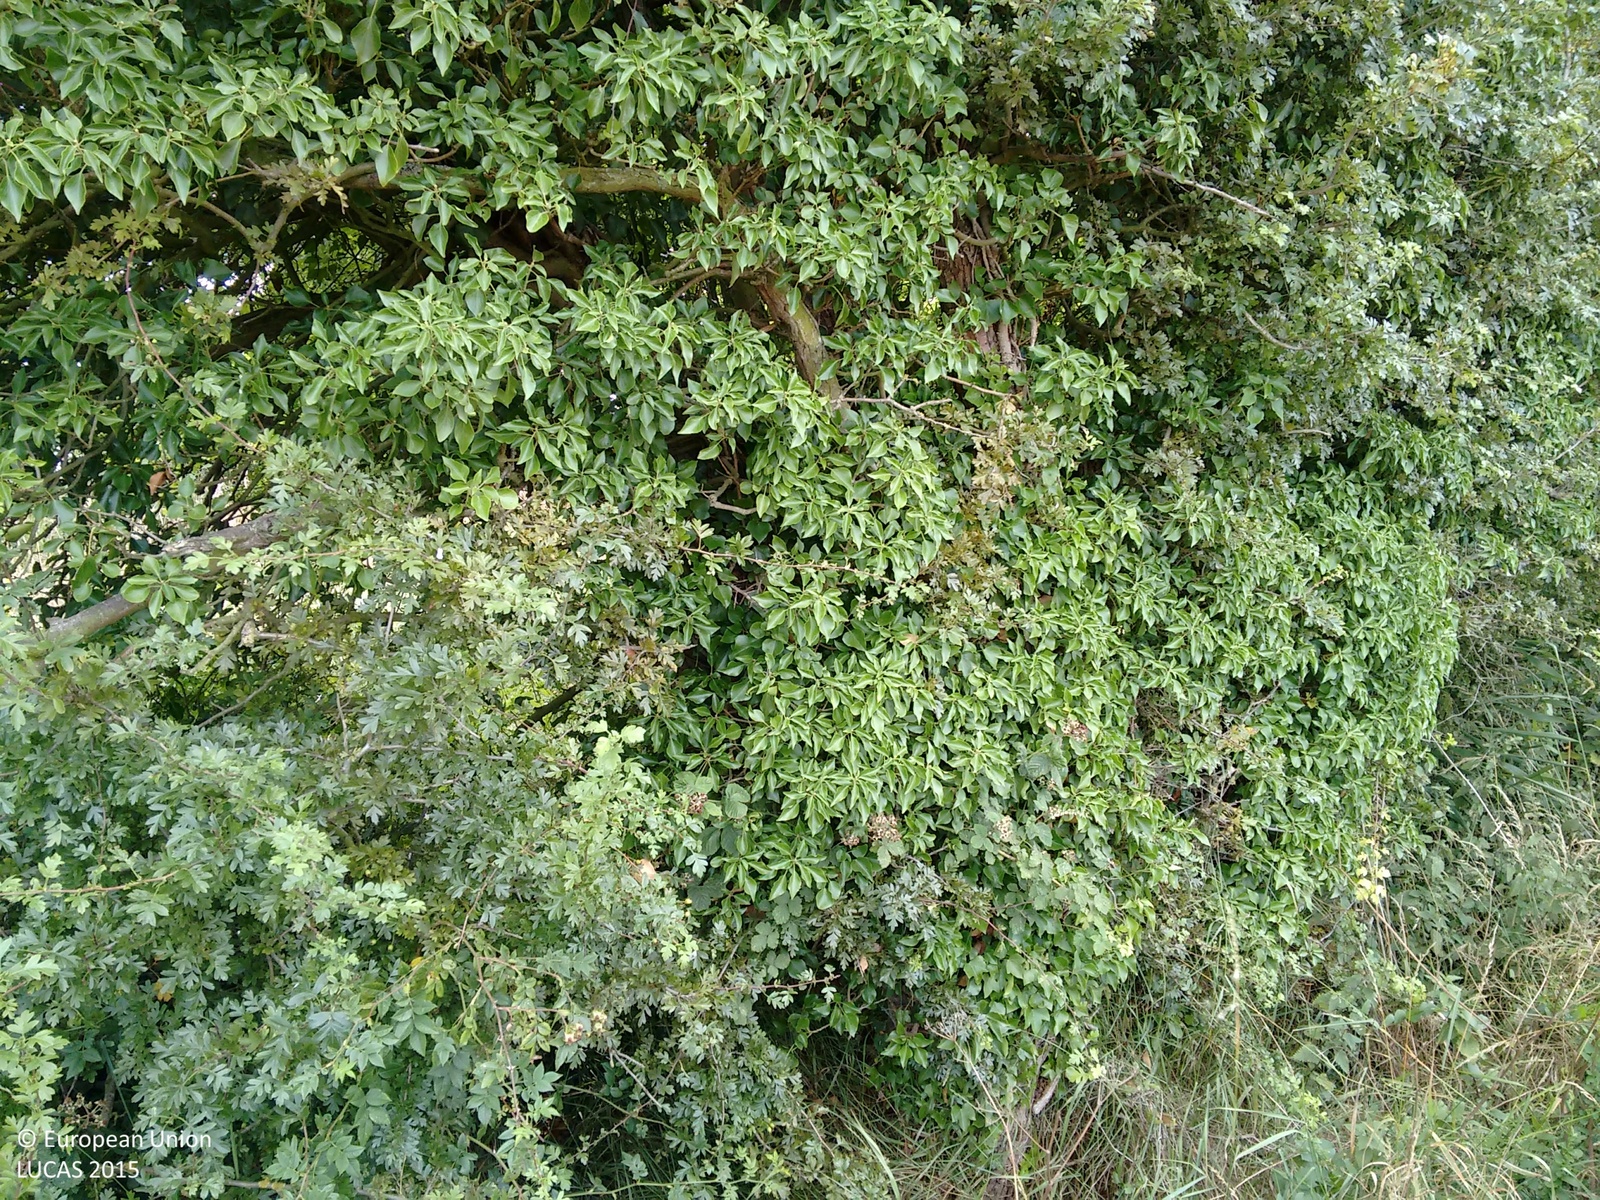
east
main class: Cropland
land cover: Rape and turnip rape
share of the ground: > 75 %
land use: Agriculture (excluding fallow land and kitchen gardens)
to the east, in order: Rape and turnip rape; Grass margins; Ditches and canals; Abandoned hedges; Grassland with sparse tree/shrub cover; Abandoned hedges; Ditches and canals; Grass margins; Common wheat
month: August
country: GB
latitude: 52.7601
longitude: 0.3241
